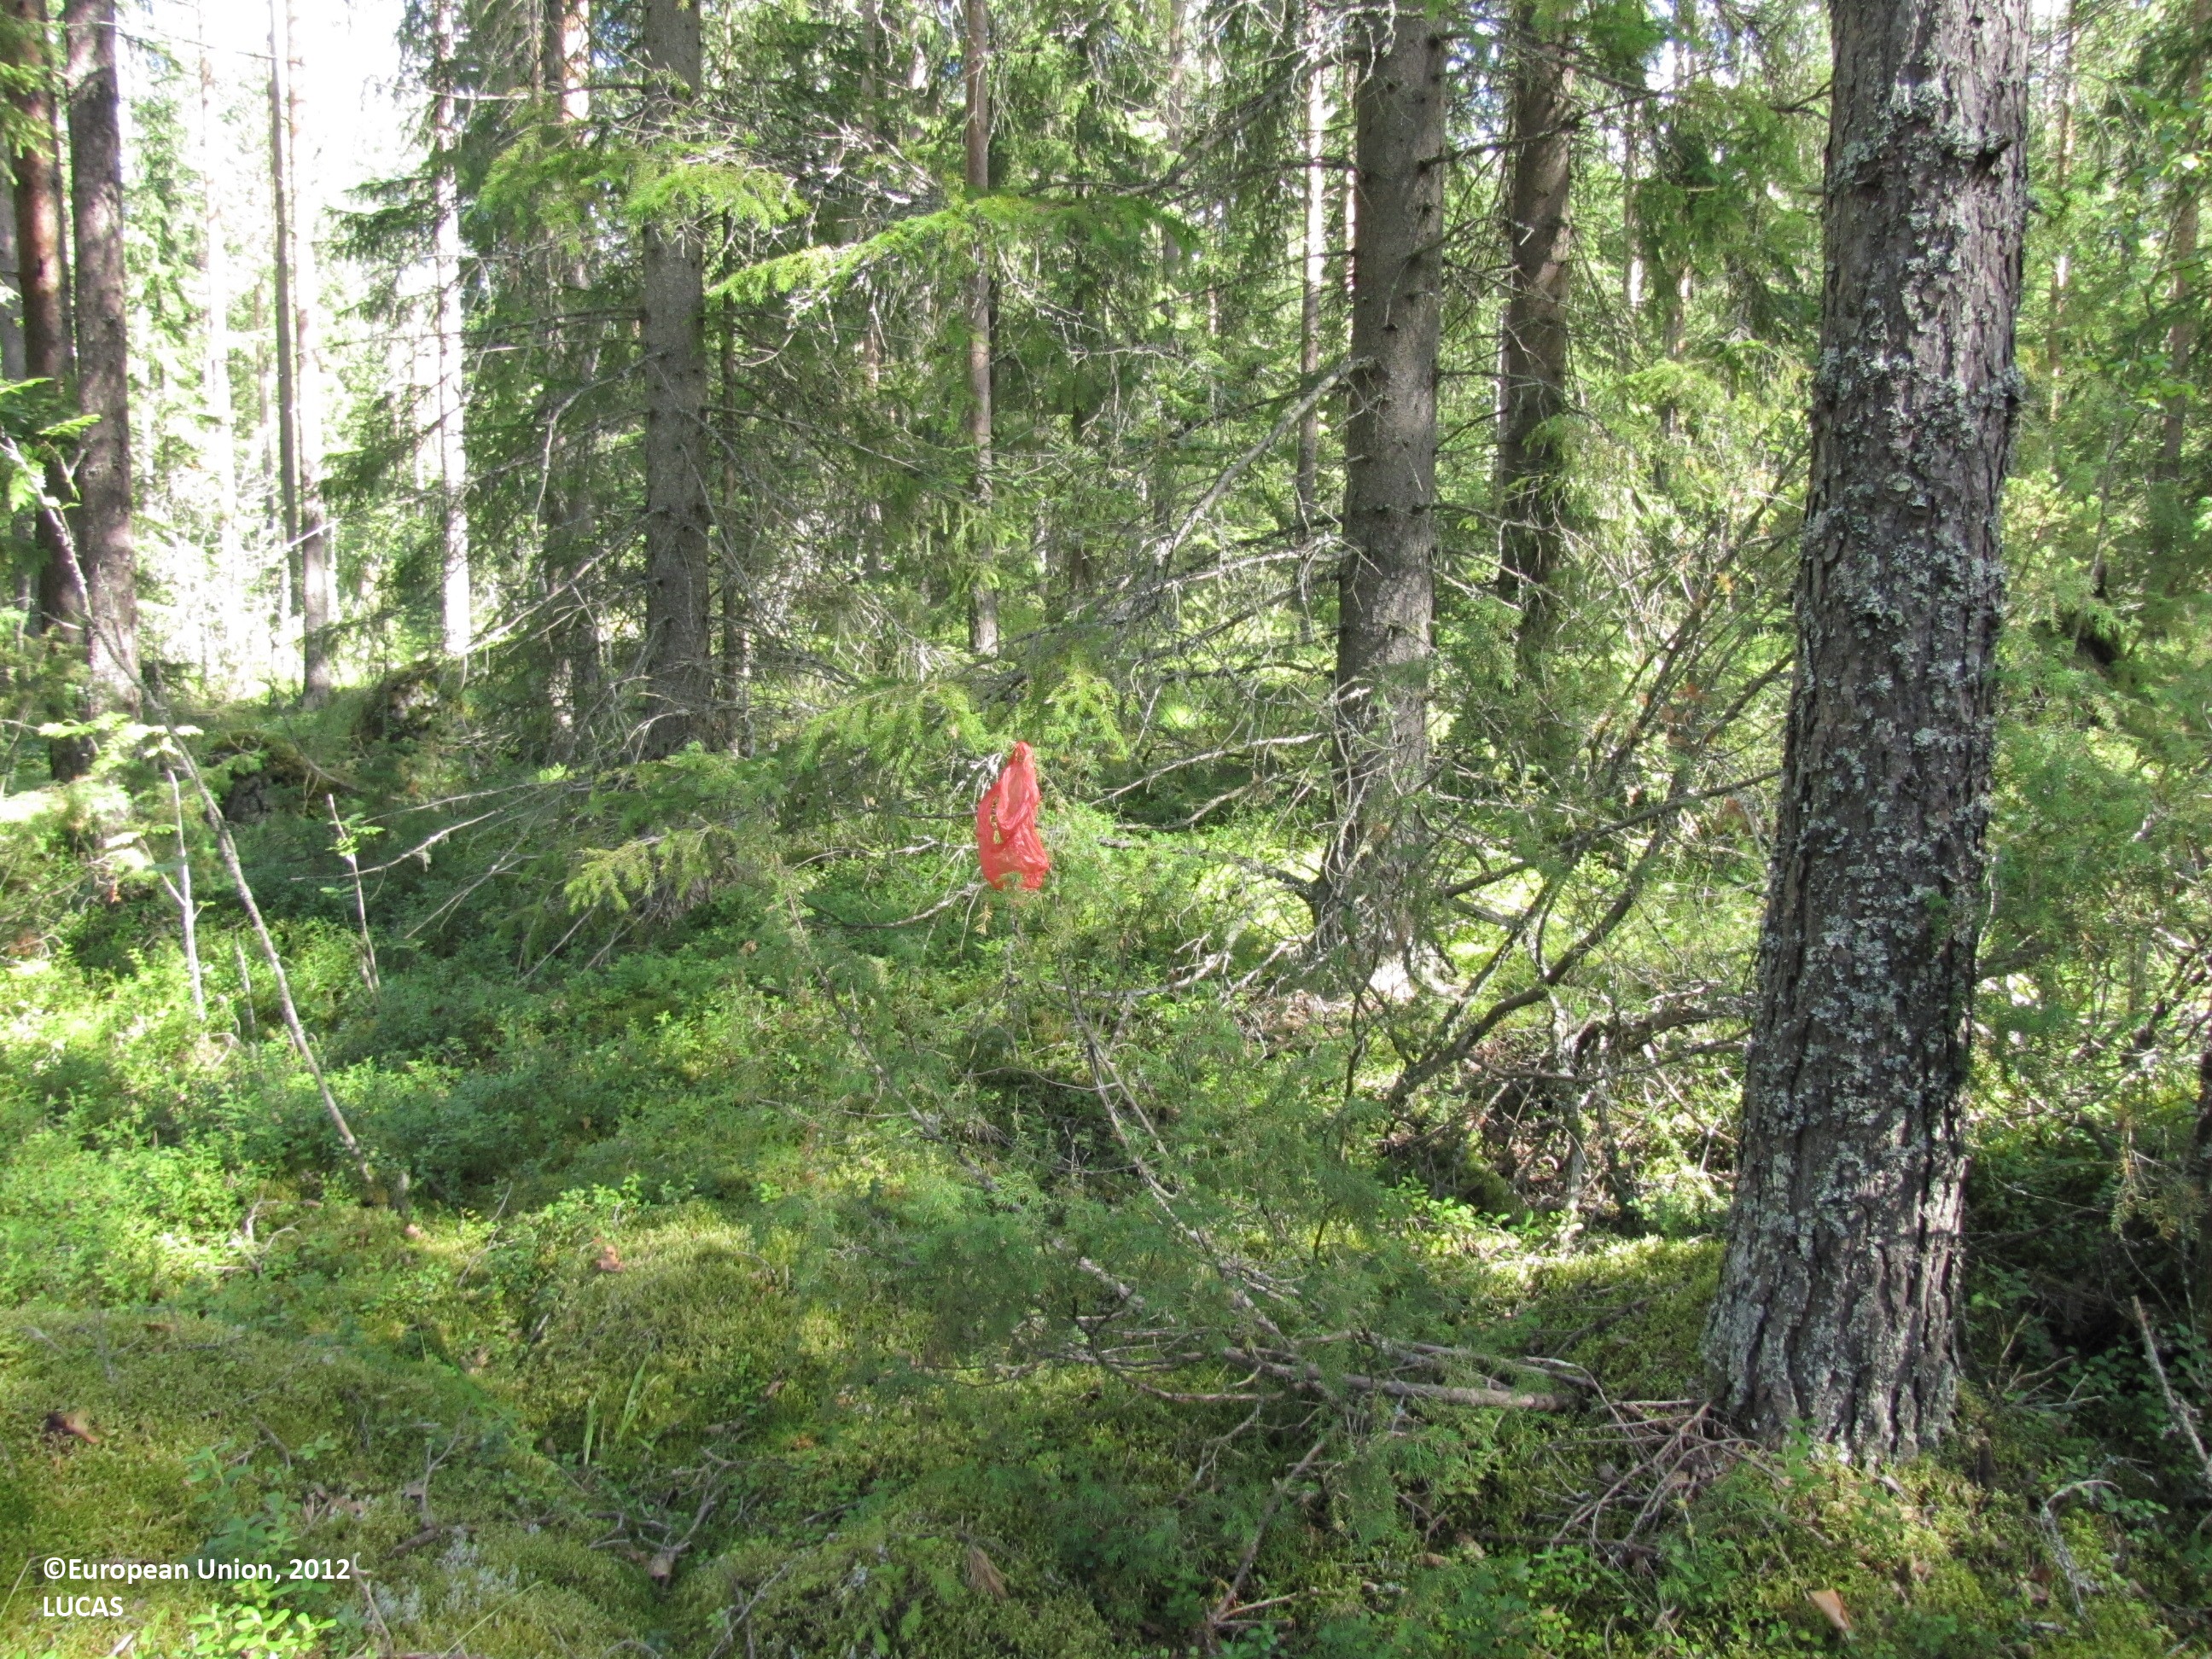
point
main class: Woodland
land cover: Other coniferous woodland
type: boreal forest
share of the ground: > 75 %
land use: Forestry
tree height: > 5 m
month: July
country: FI
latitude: 62.1163
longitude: 23.2376
